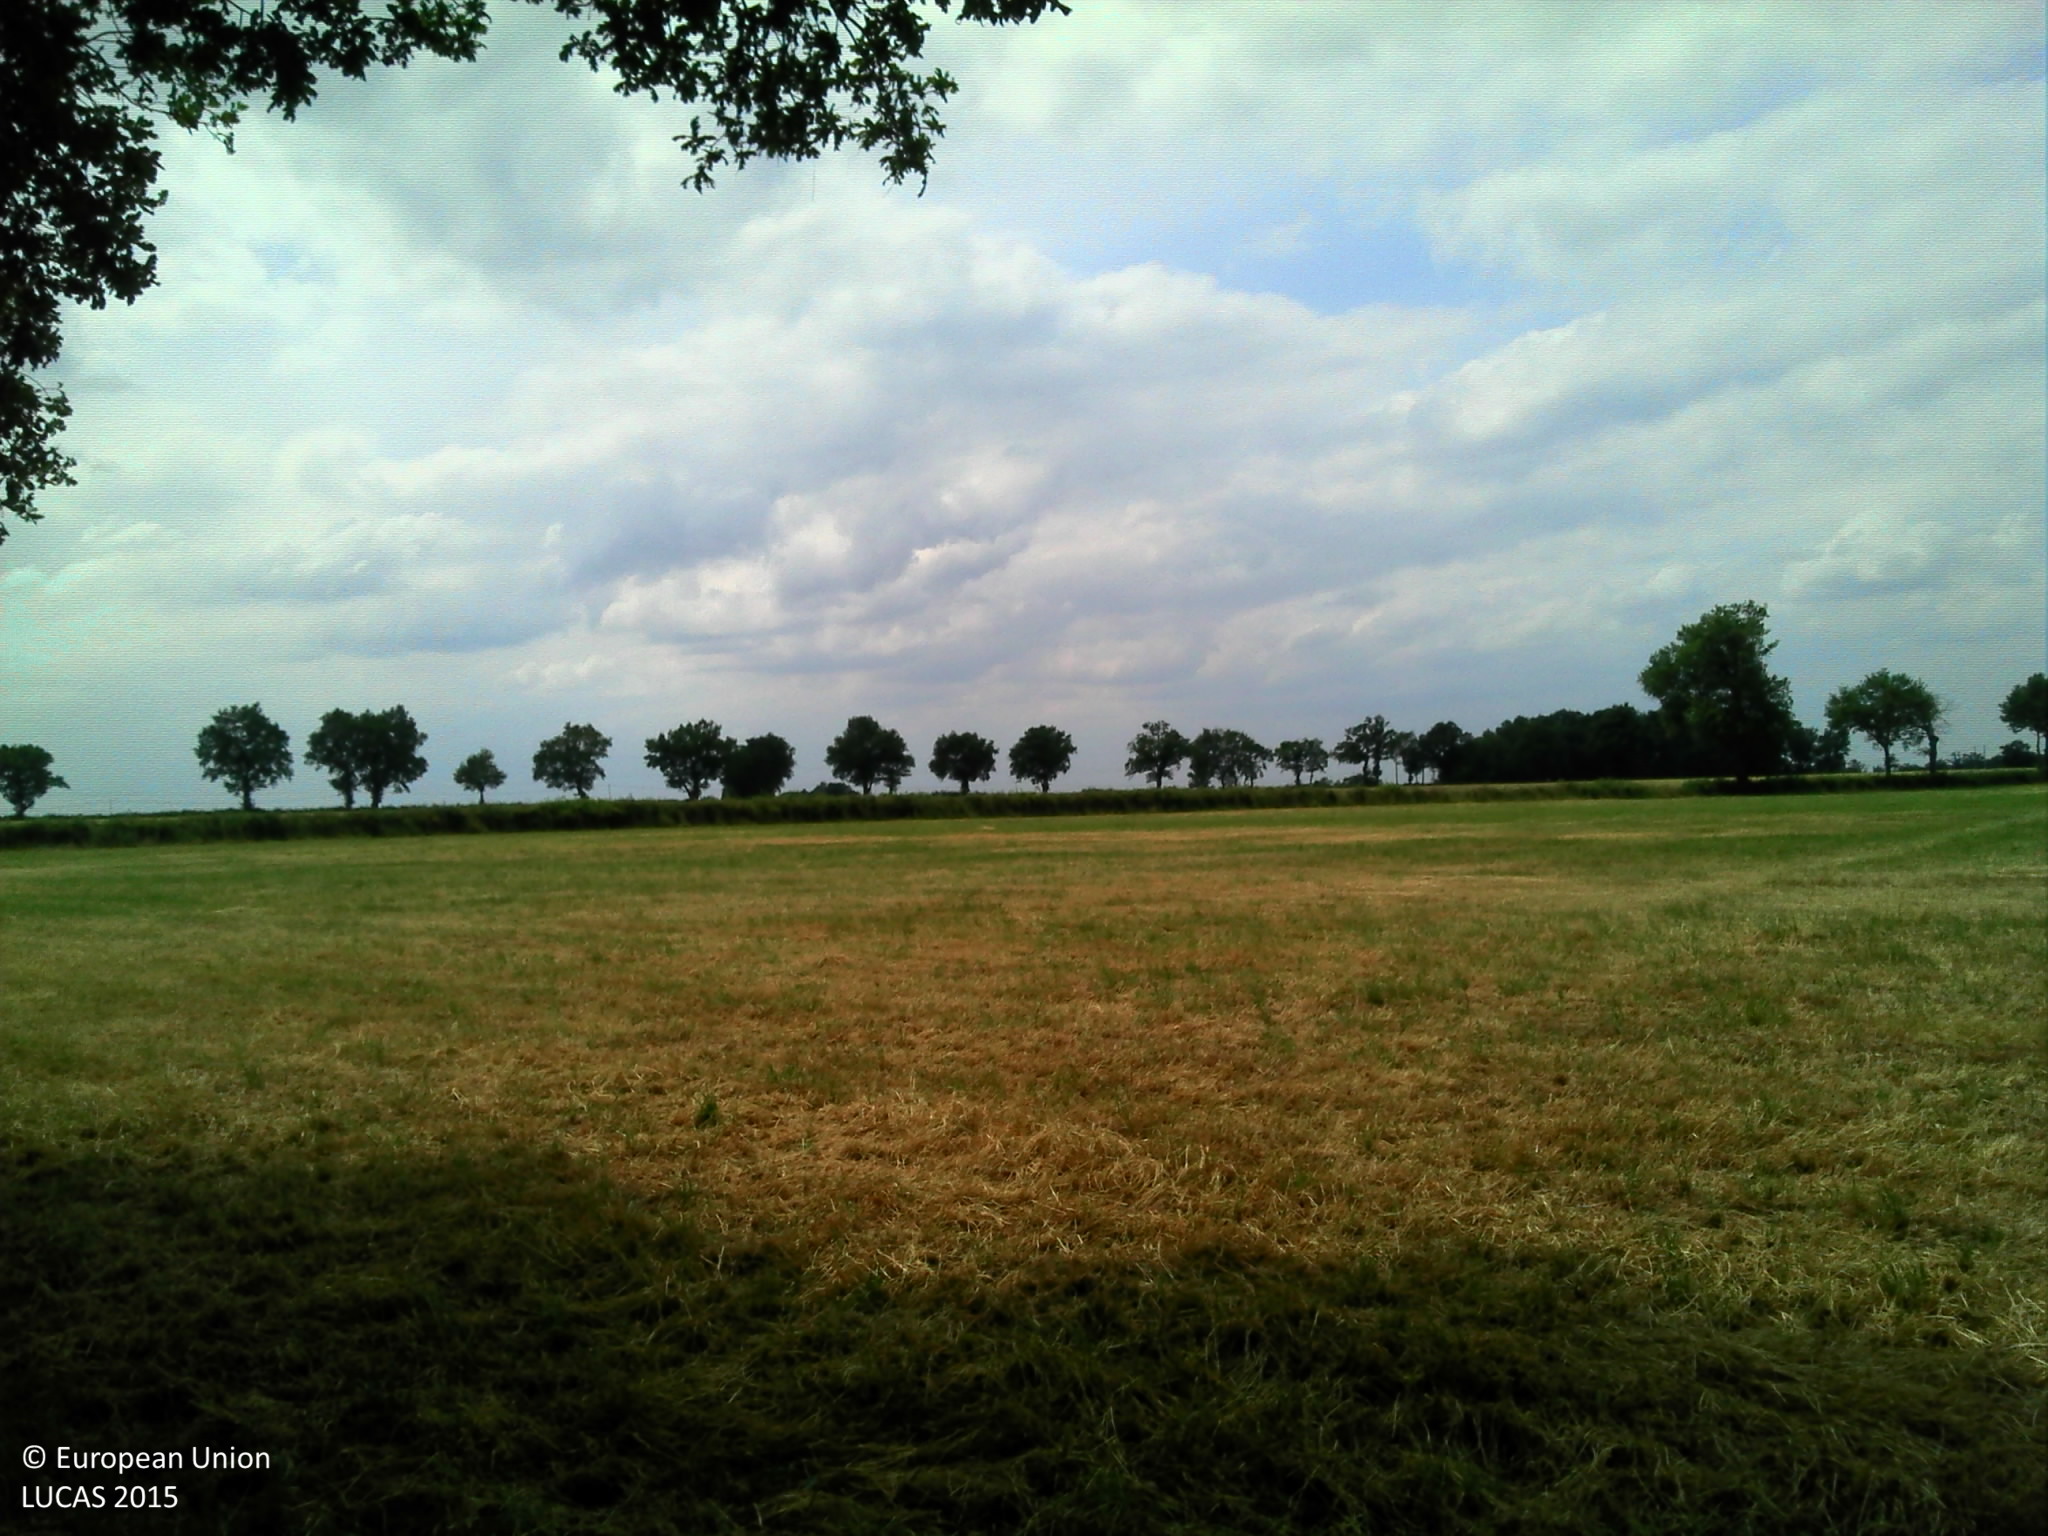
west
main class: Cropland
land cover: Temporary grasslands
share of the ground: > 75 %
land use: Agriculture (excluding fallow land and kitchen gardens)
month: June
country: FR
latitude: 46.4194
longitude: 2.8537
